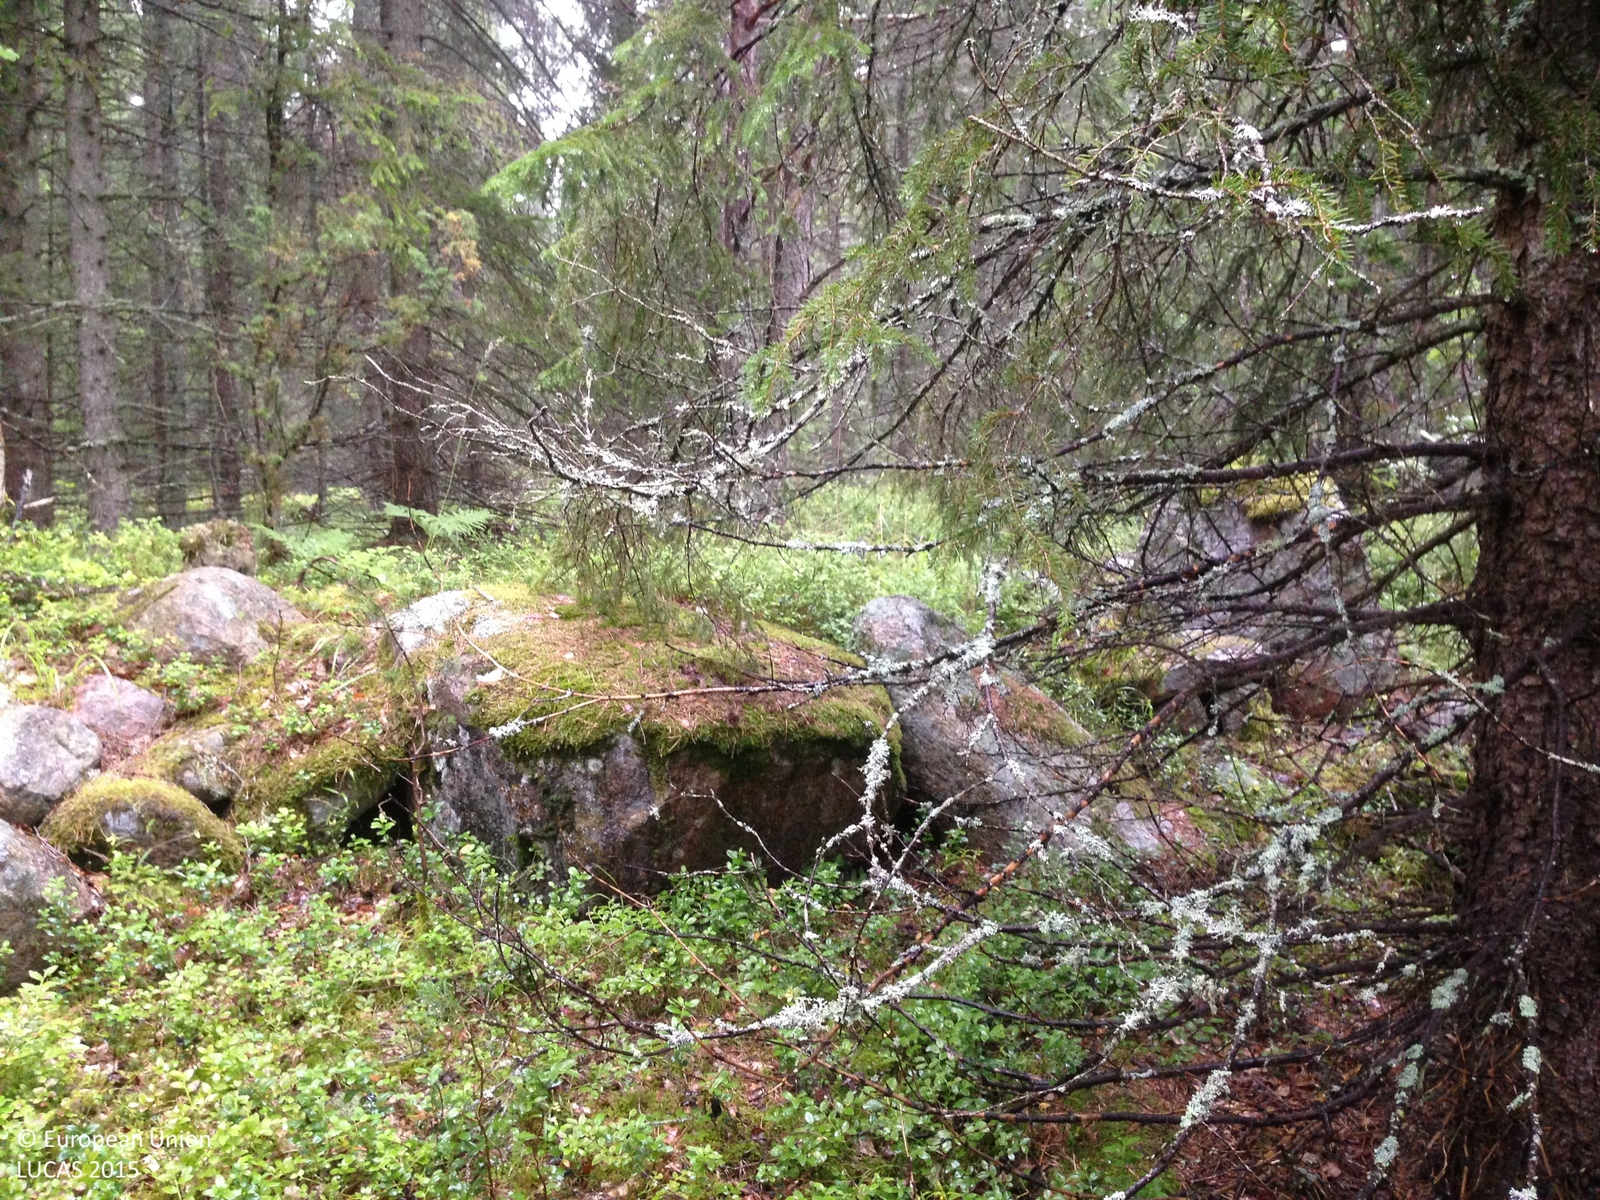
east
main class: Woodland
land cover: Spruce dominated coniferous woodland
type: boreal forest
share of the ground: > 75 %
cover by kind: coniferous forest trees 70 %, shrubs 15 %, lichens and mosses 10 %, broadleaved forest trees 5 %
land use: Forestry
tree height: > 5 m
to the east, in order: Spruce dominated coniferous woodland; Spruce dominated mixed woodland; Spruce dominated coniferous woodland; Pine dominated coniferous woodland
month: July
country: SE
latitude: 59.9577
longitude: 18.5399
